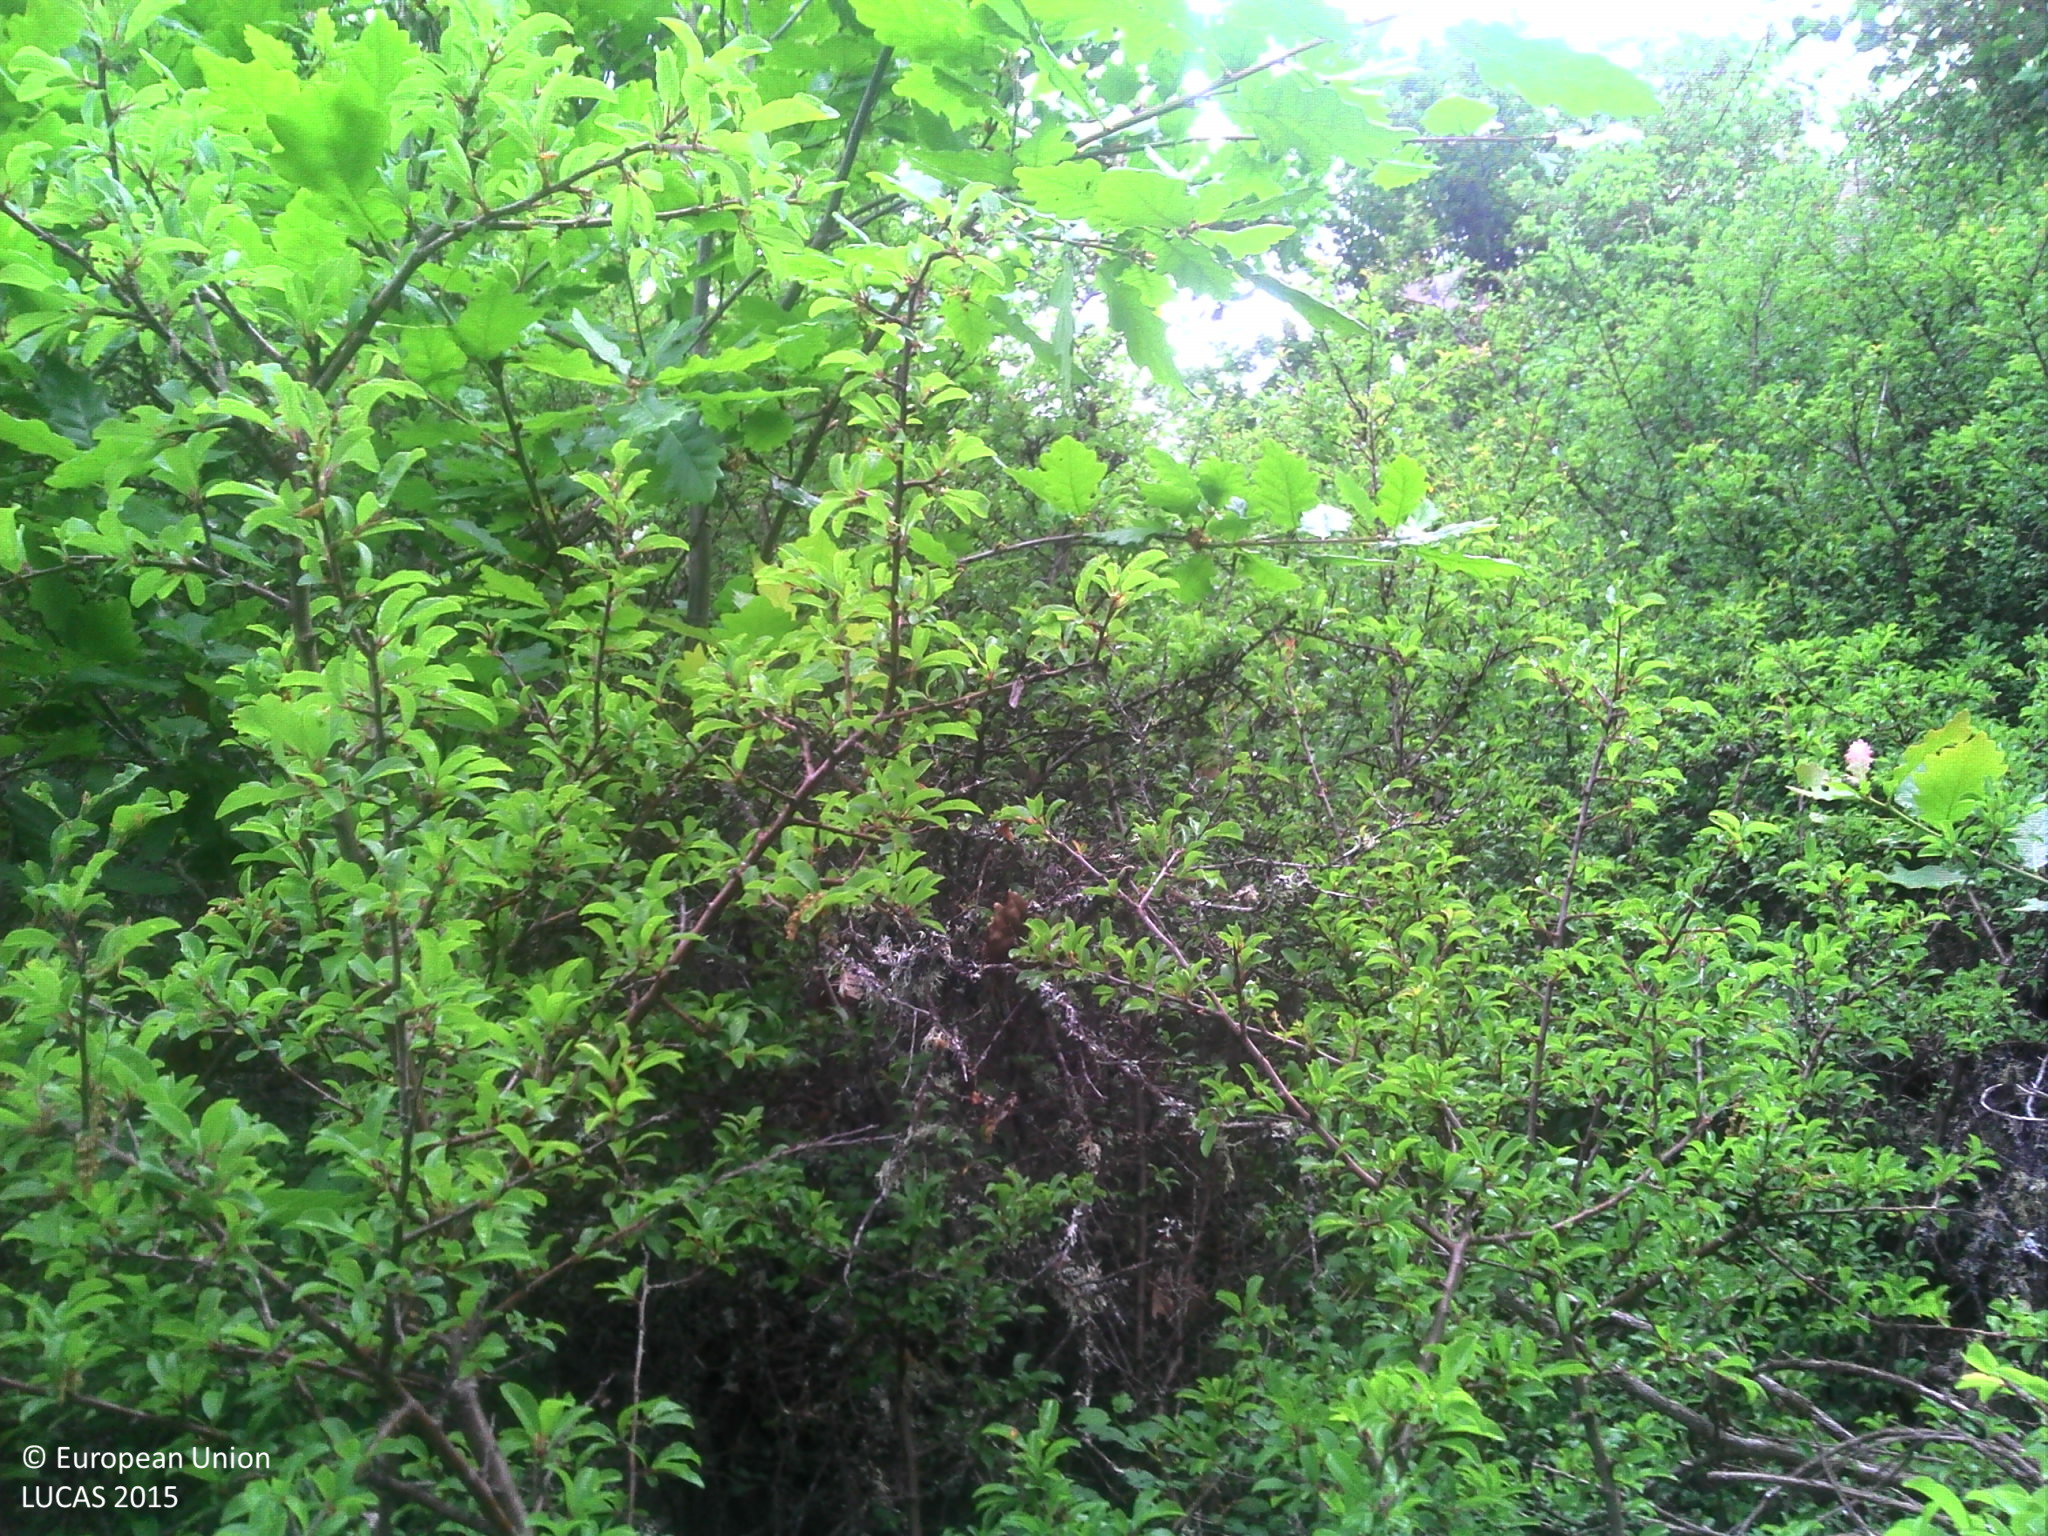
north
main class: Shrubland
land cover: Shrubland with sparse tree cover
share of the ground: > 75 %
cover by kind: shrubs 85 %, herbaceous plants 10 %, broadleaved forest trees 5 %
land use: Semi-natural and natural areas not in use
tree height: > 5 m
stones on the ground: < 10 %
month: June
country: FR
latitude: 45.1583
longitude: 3.1964
